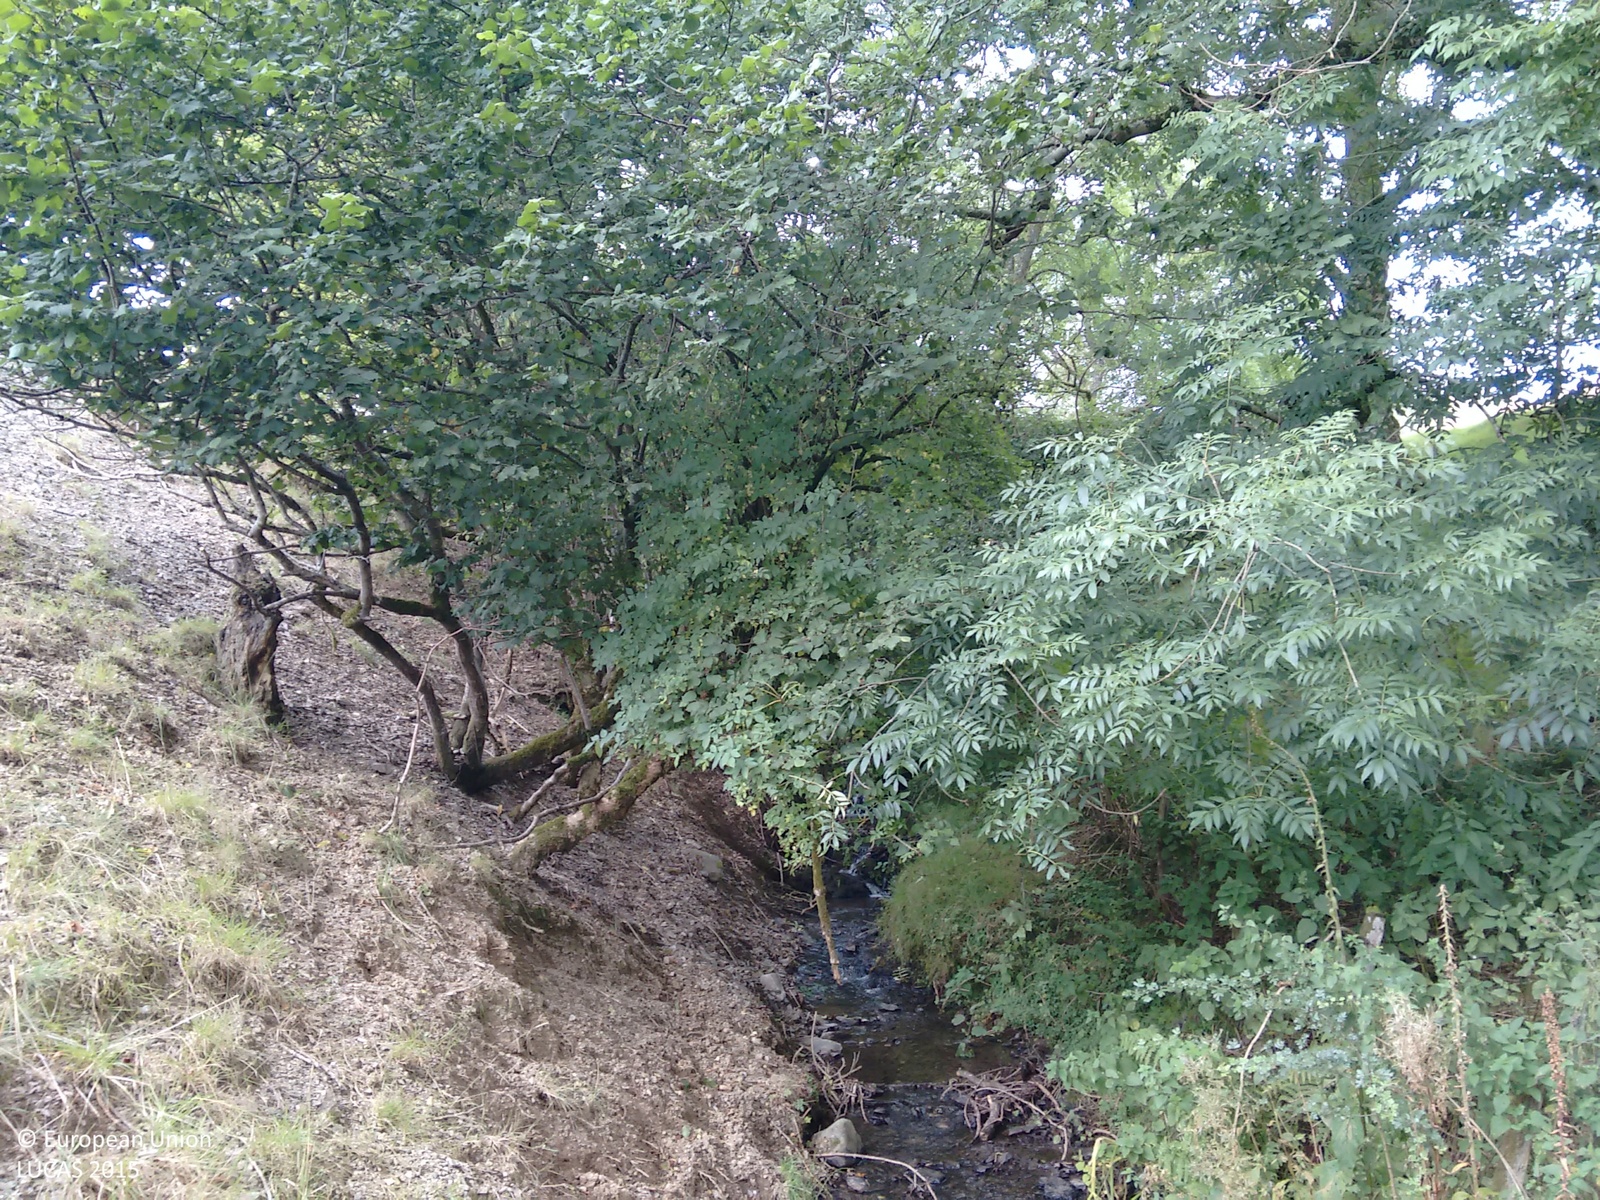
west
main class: Woodland
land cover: Broadleaved woodland
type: mesophytic deciduous forest
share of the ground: > 75 %
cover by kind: broadleaved forest trees 80 %, herbaceous plants 20 %
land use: Agriculture (excluding fallow land and kitchen gardens)
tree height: > 5 m
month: September
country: GB
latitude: 52.1823
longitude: -3.5257
